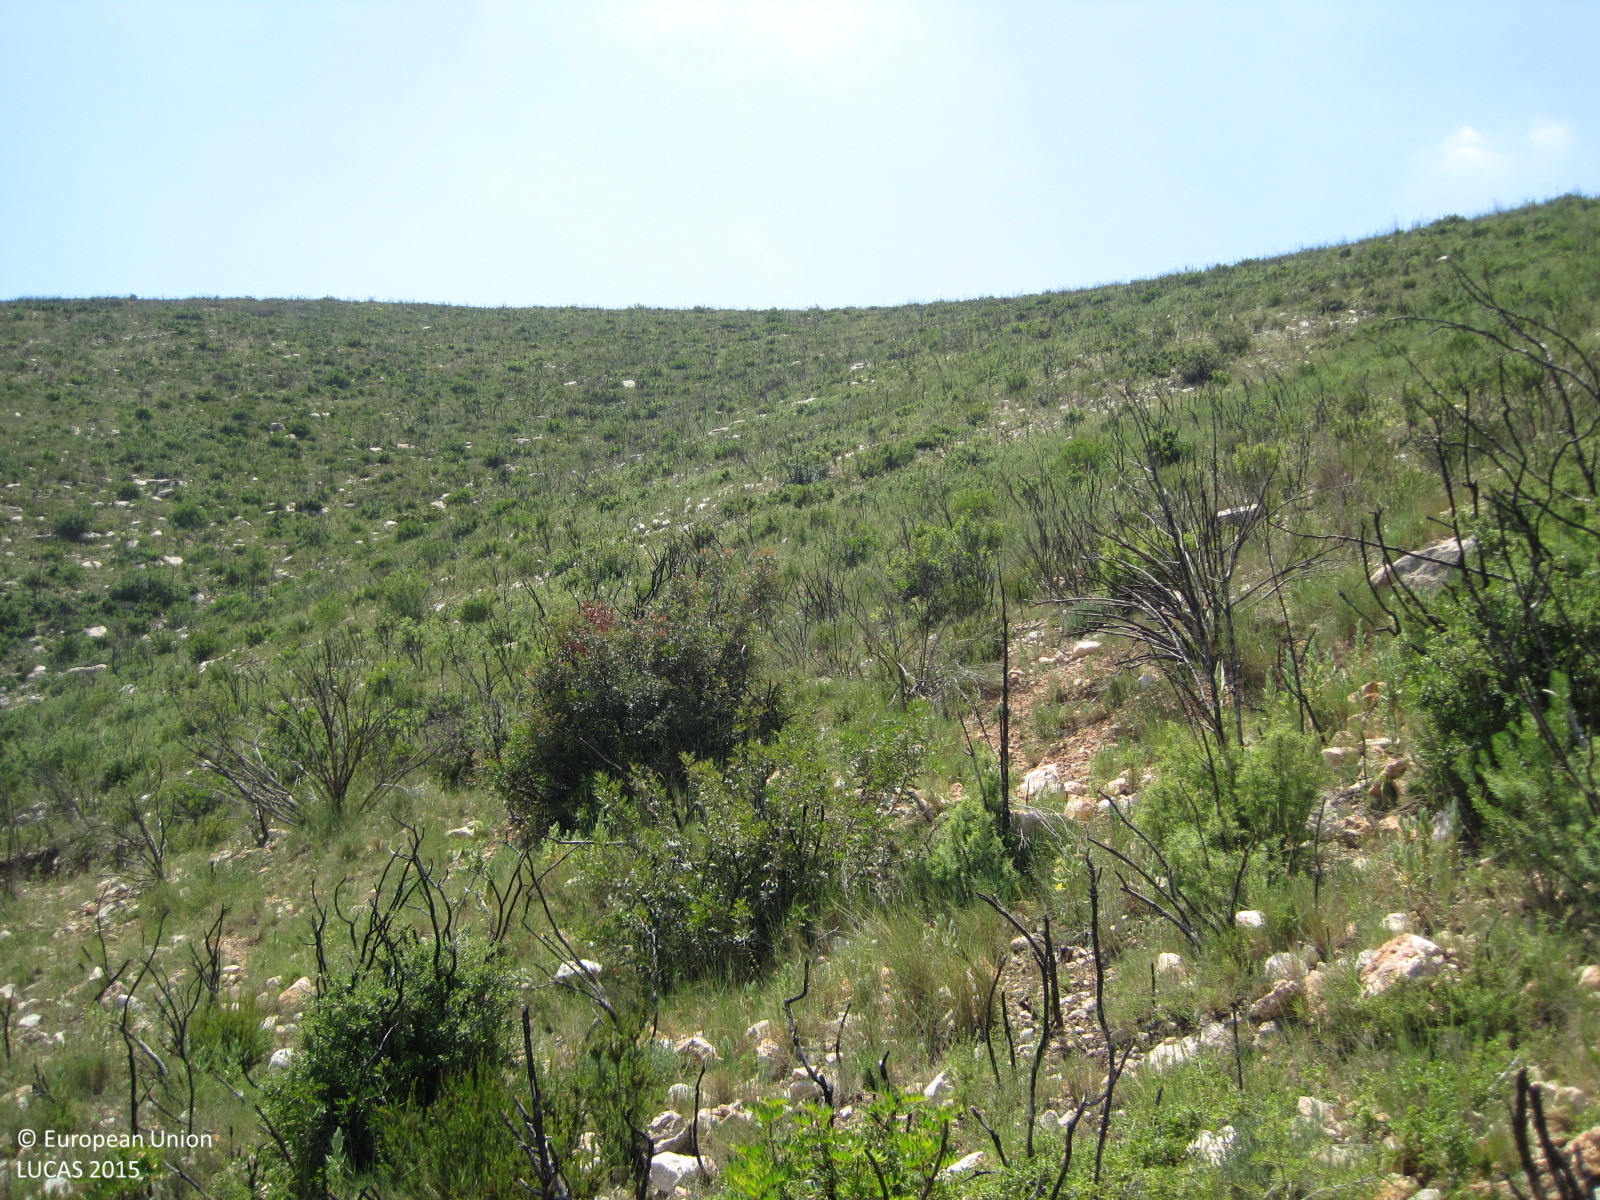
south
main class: Shrubland
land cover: Shrubland without tree cover
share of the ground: 50 - 75 %
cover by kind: shrubs 50 %, consolidated bare surface 35 %, herbaceous plants 15 %
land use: Semi-natural and natural areas not in use
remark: Burnt area
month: June
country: ES
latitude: 39.2642
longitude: -0.8338
